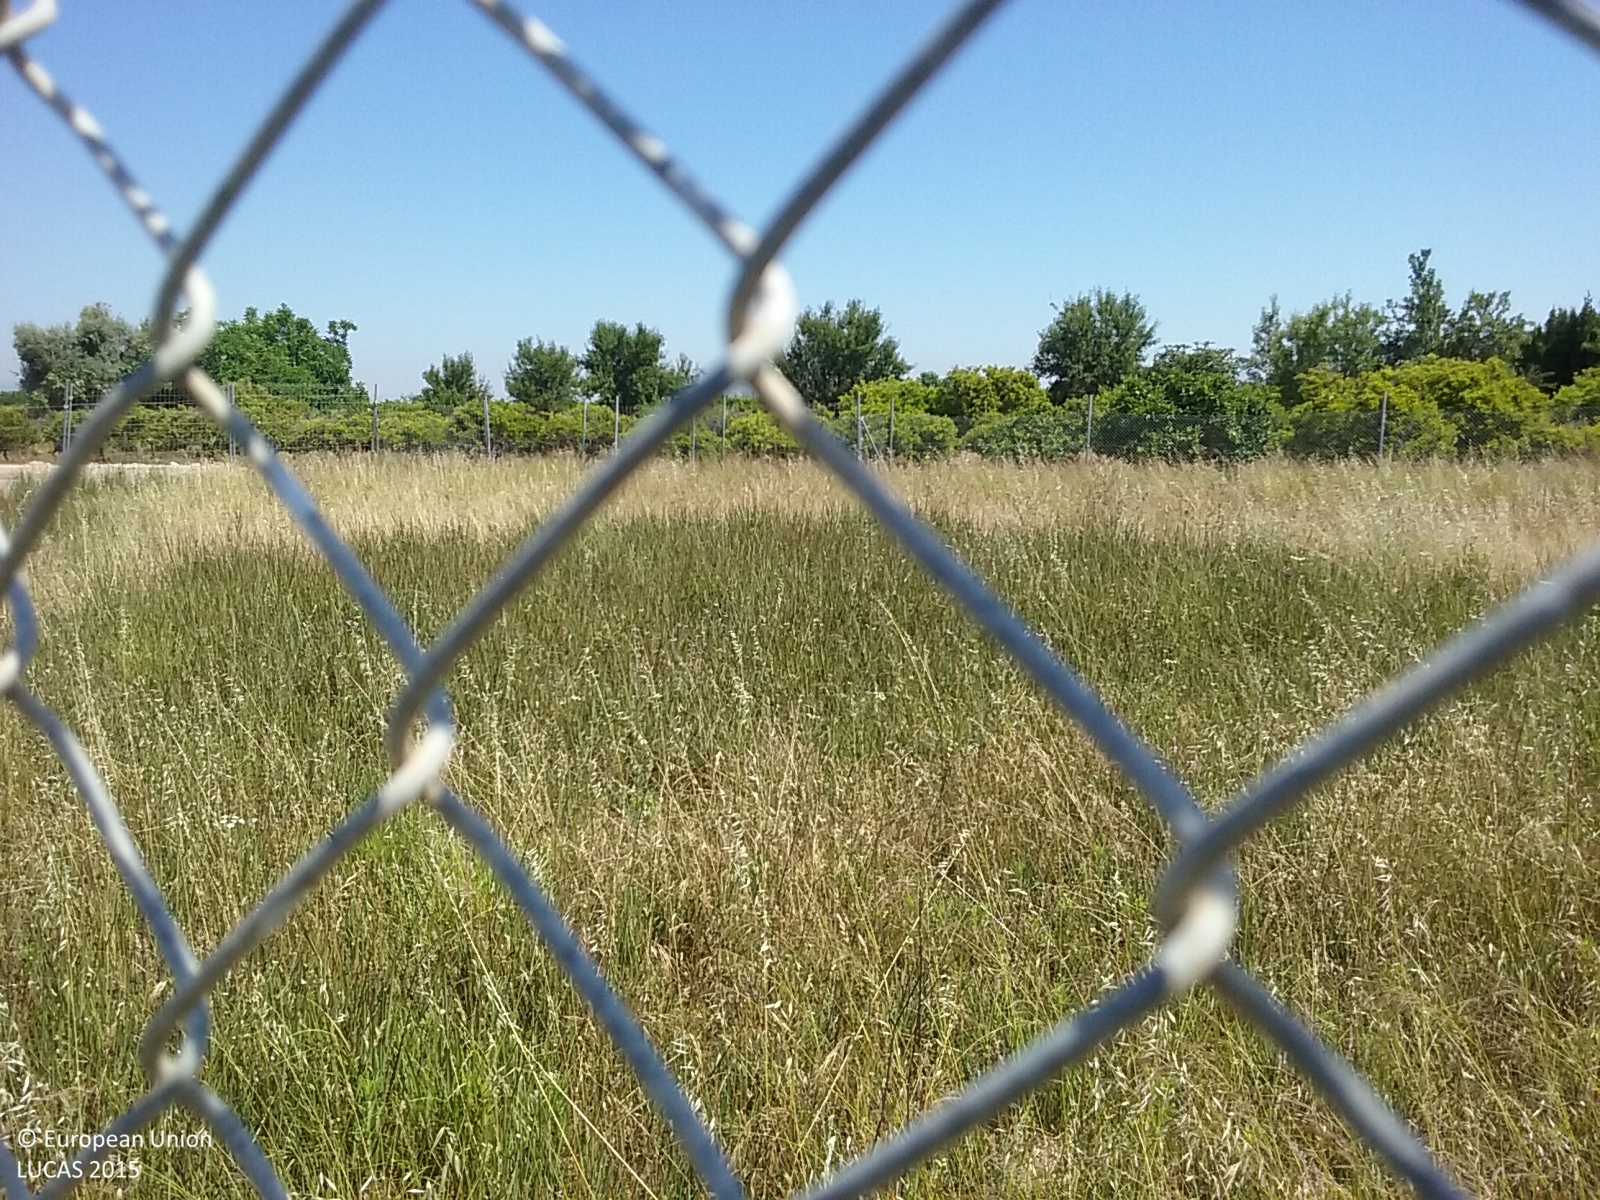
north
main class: Grassland
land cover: Grassland without tree/shrub cover
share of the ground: > 75 %
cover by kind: herbaceous plants 95 %, unconsolidated bare surface 5 %
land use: Abandoned areas
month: June
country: ES
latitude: 39.8530
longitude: -0.1103
